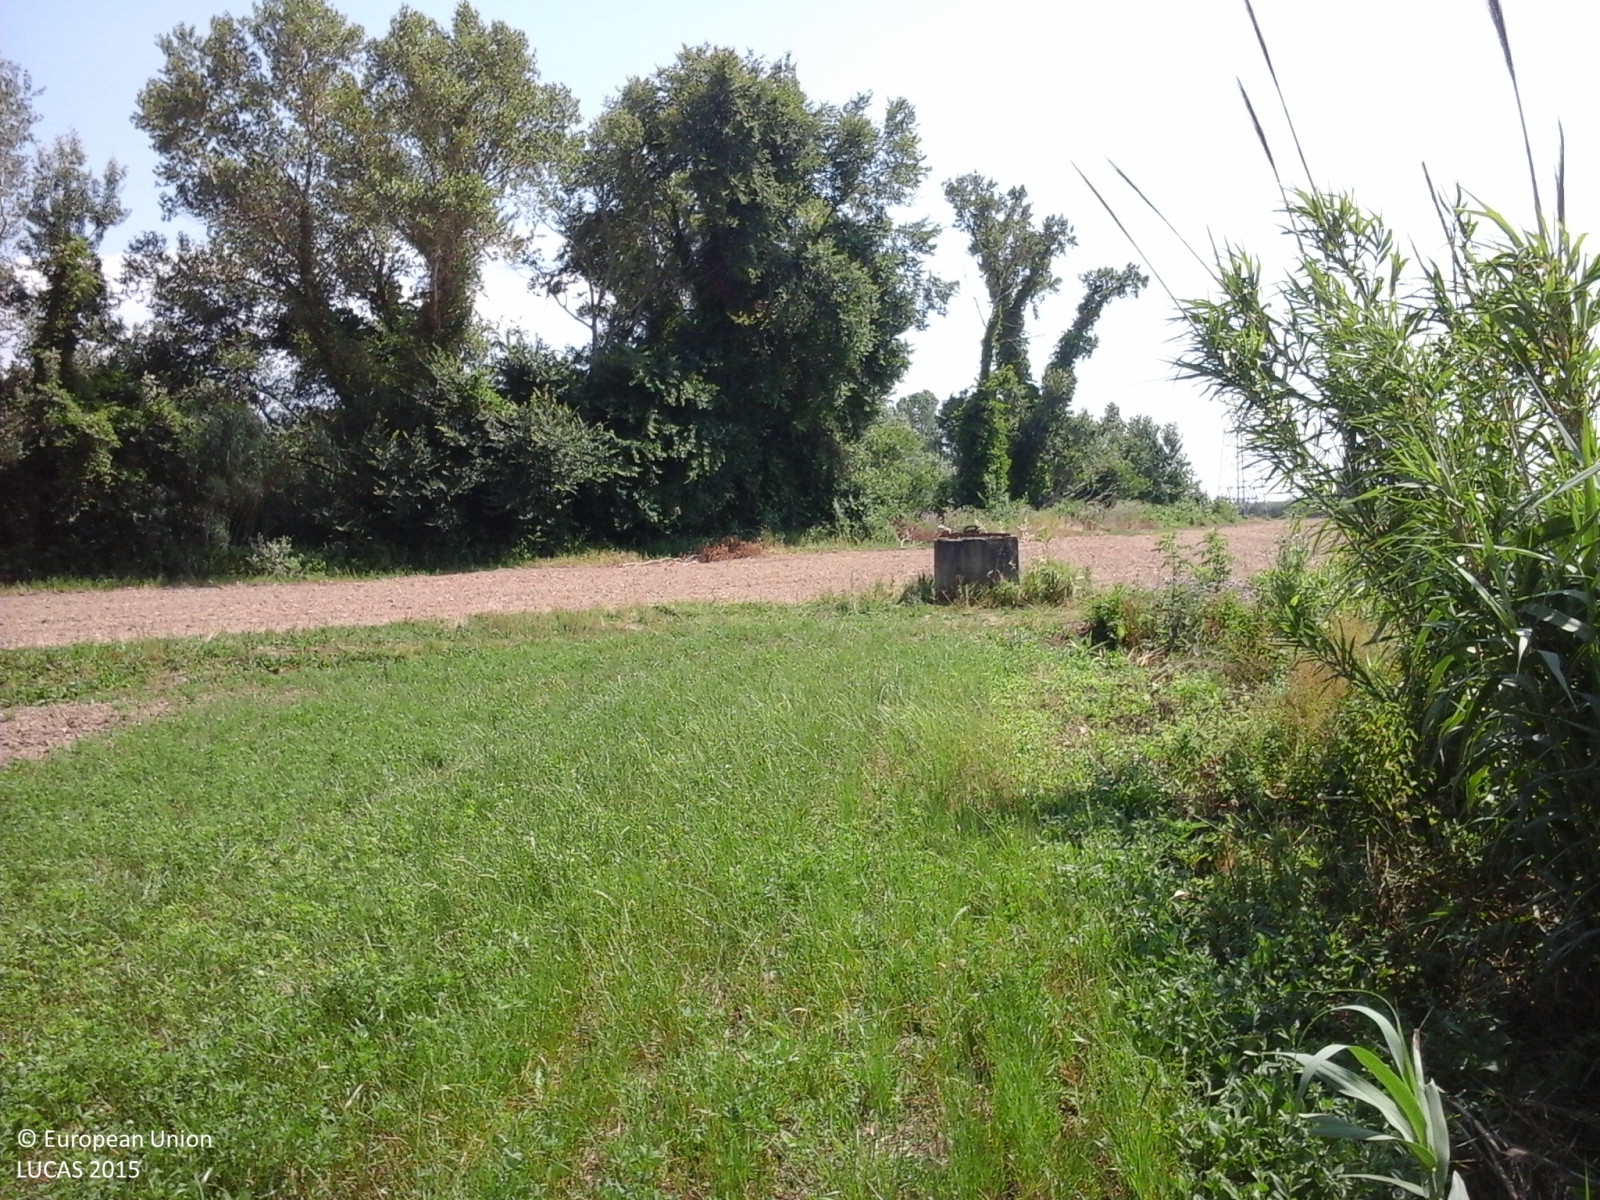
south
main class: Cropland
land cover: Lucerne
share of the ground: > 75 %
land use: Agriculture (excluding fallow land and kitchen gardens)
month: June
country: IT
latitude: 40.5364
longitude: 15.0436
